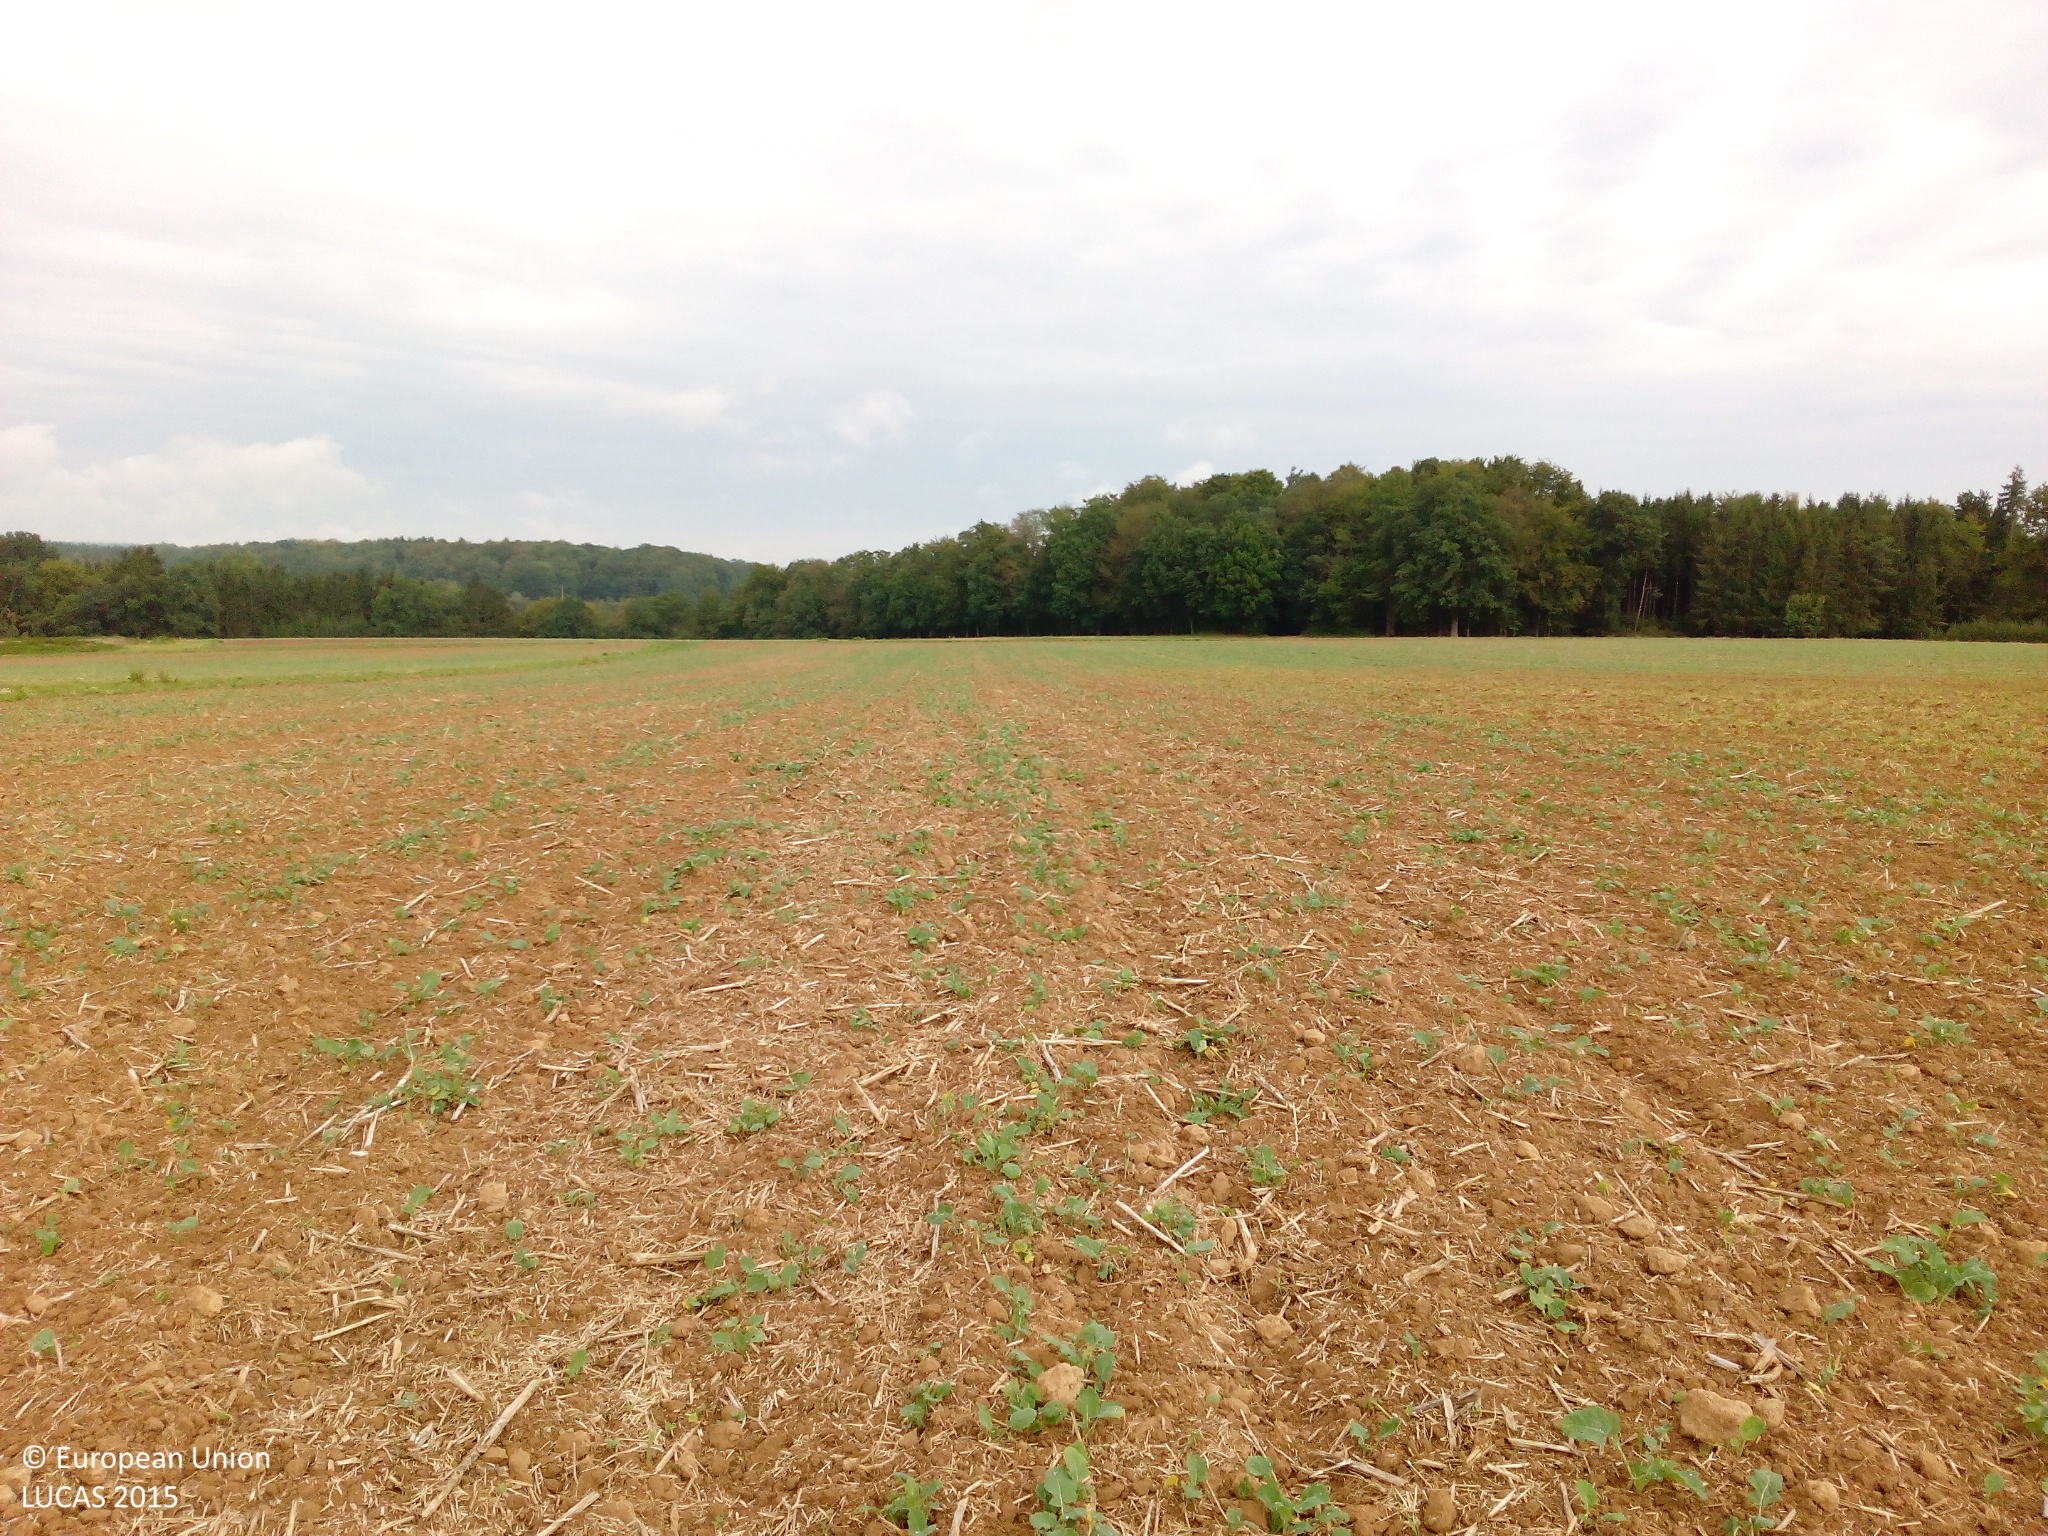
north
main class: Cropland
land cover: Rape and turnip rape
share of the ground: < 10 %
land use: Agriculture (excluding fallow land and kitchen gardens)
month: September
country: DE
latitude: 49.7151
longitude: 9.4038
